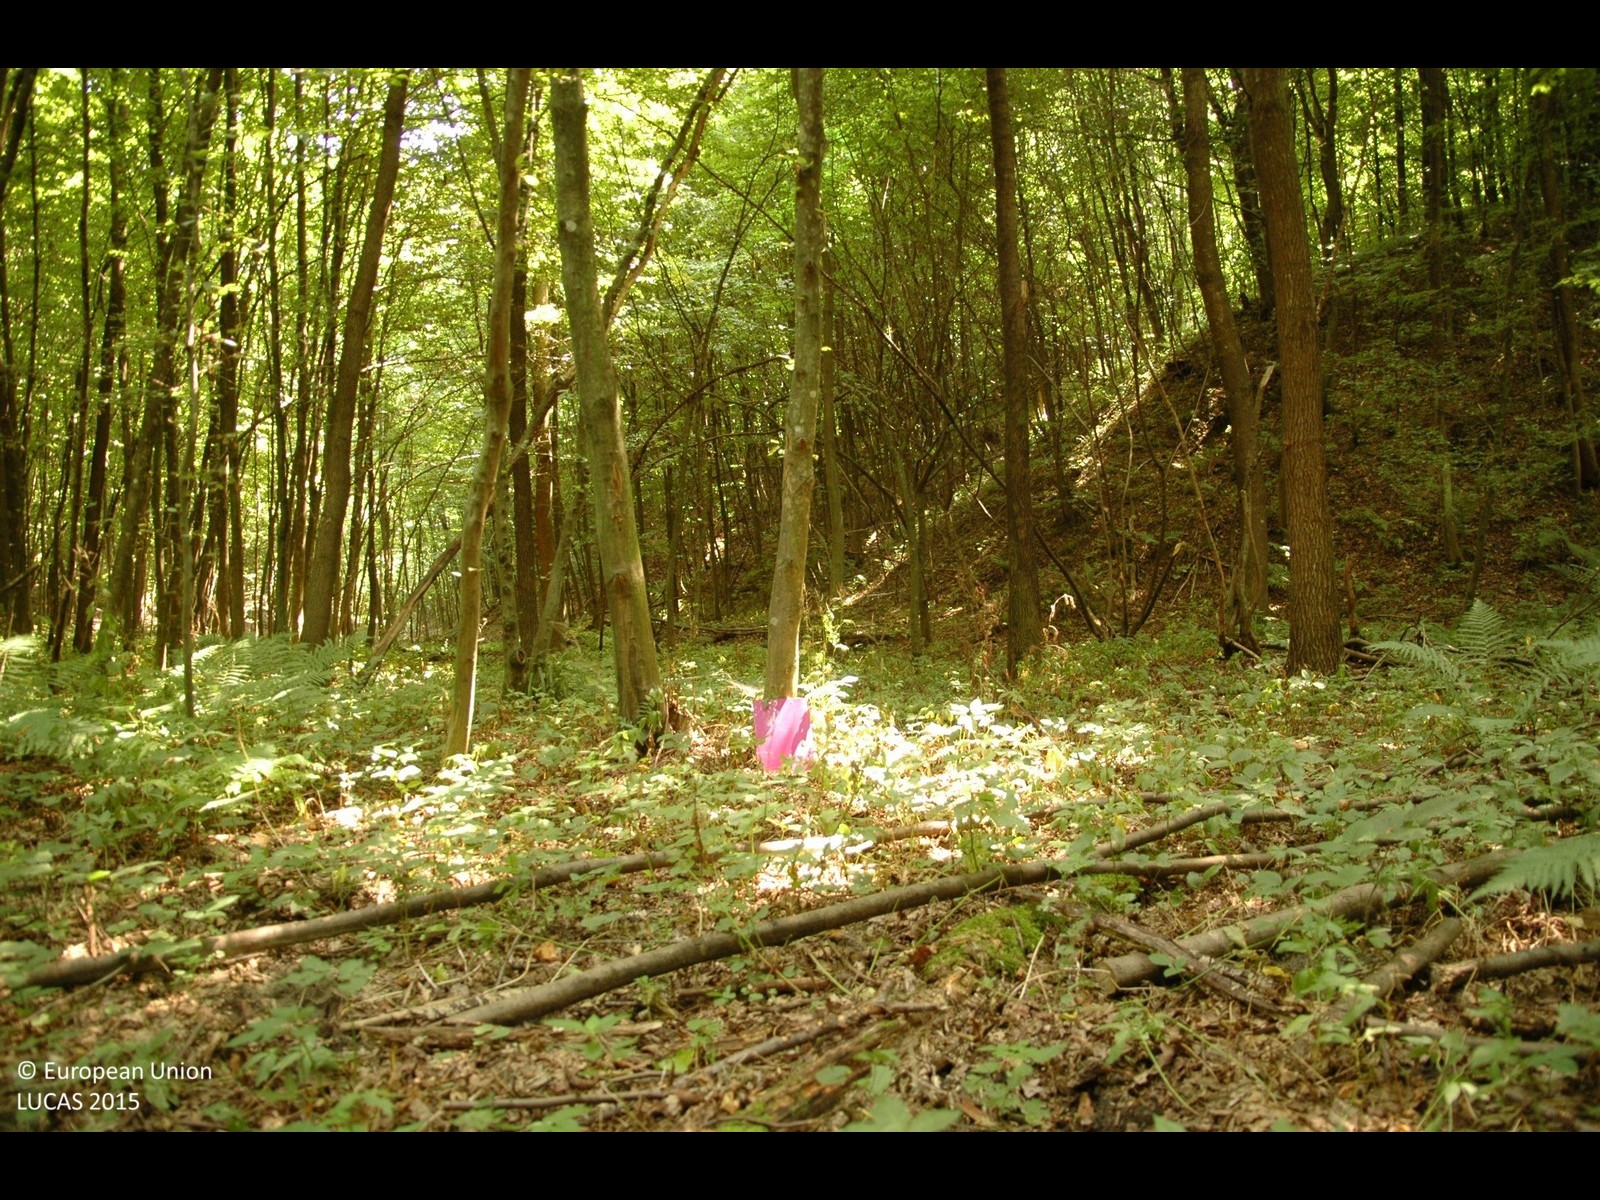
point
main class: Woodland
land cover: Broadleaved woodland
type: mesophytic deciduous forest
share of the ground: > 75 %
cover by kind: broadleaved forest trees 100 %
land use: Forestry
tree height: > 5 m
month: July
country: HR
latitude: 46.1594
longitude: 16.6958
